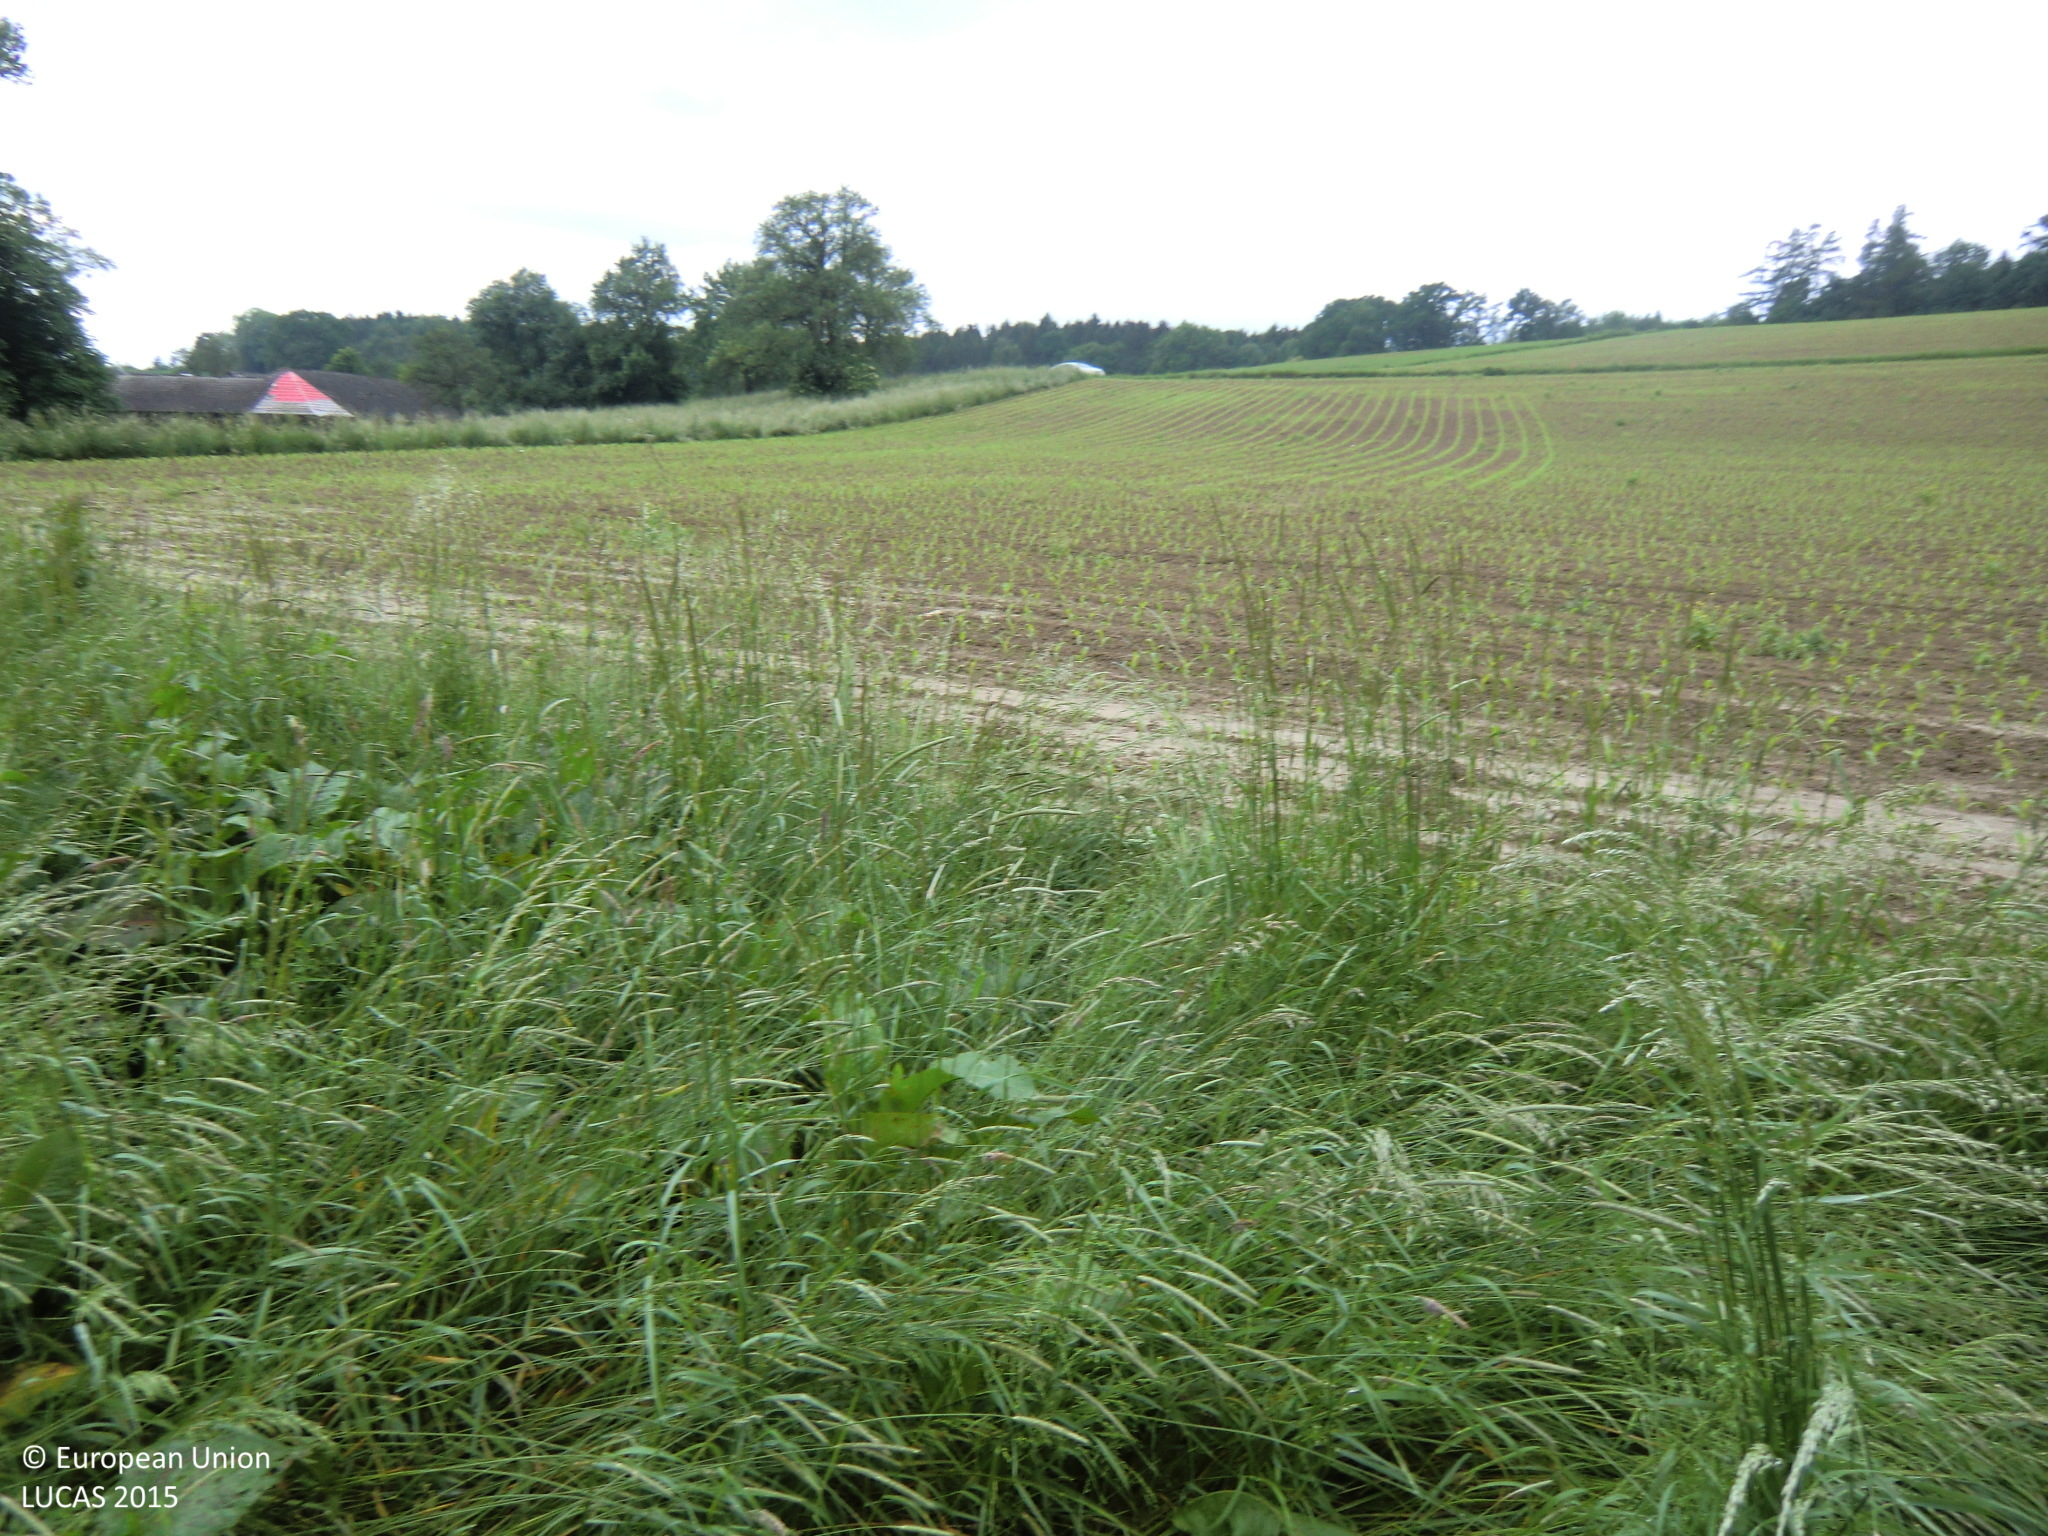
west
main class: Grassland
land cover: Grassland without tree/shrub cover
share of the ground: > 75 %
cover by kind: herbaceous plants 100 %
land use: Agriculture (excluding fallow land and kitchen gardens)
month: May
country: AT
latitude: 48.1291
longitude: 15.3628
